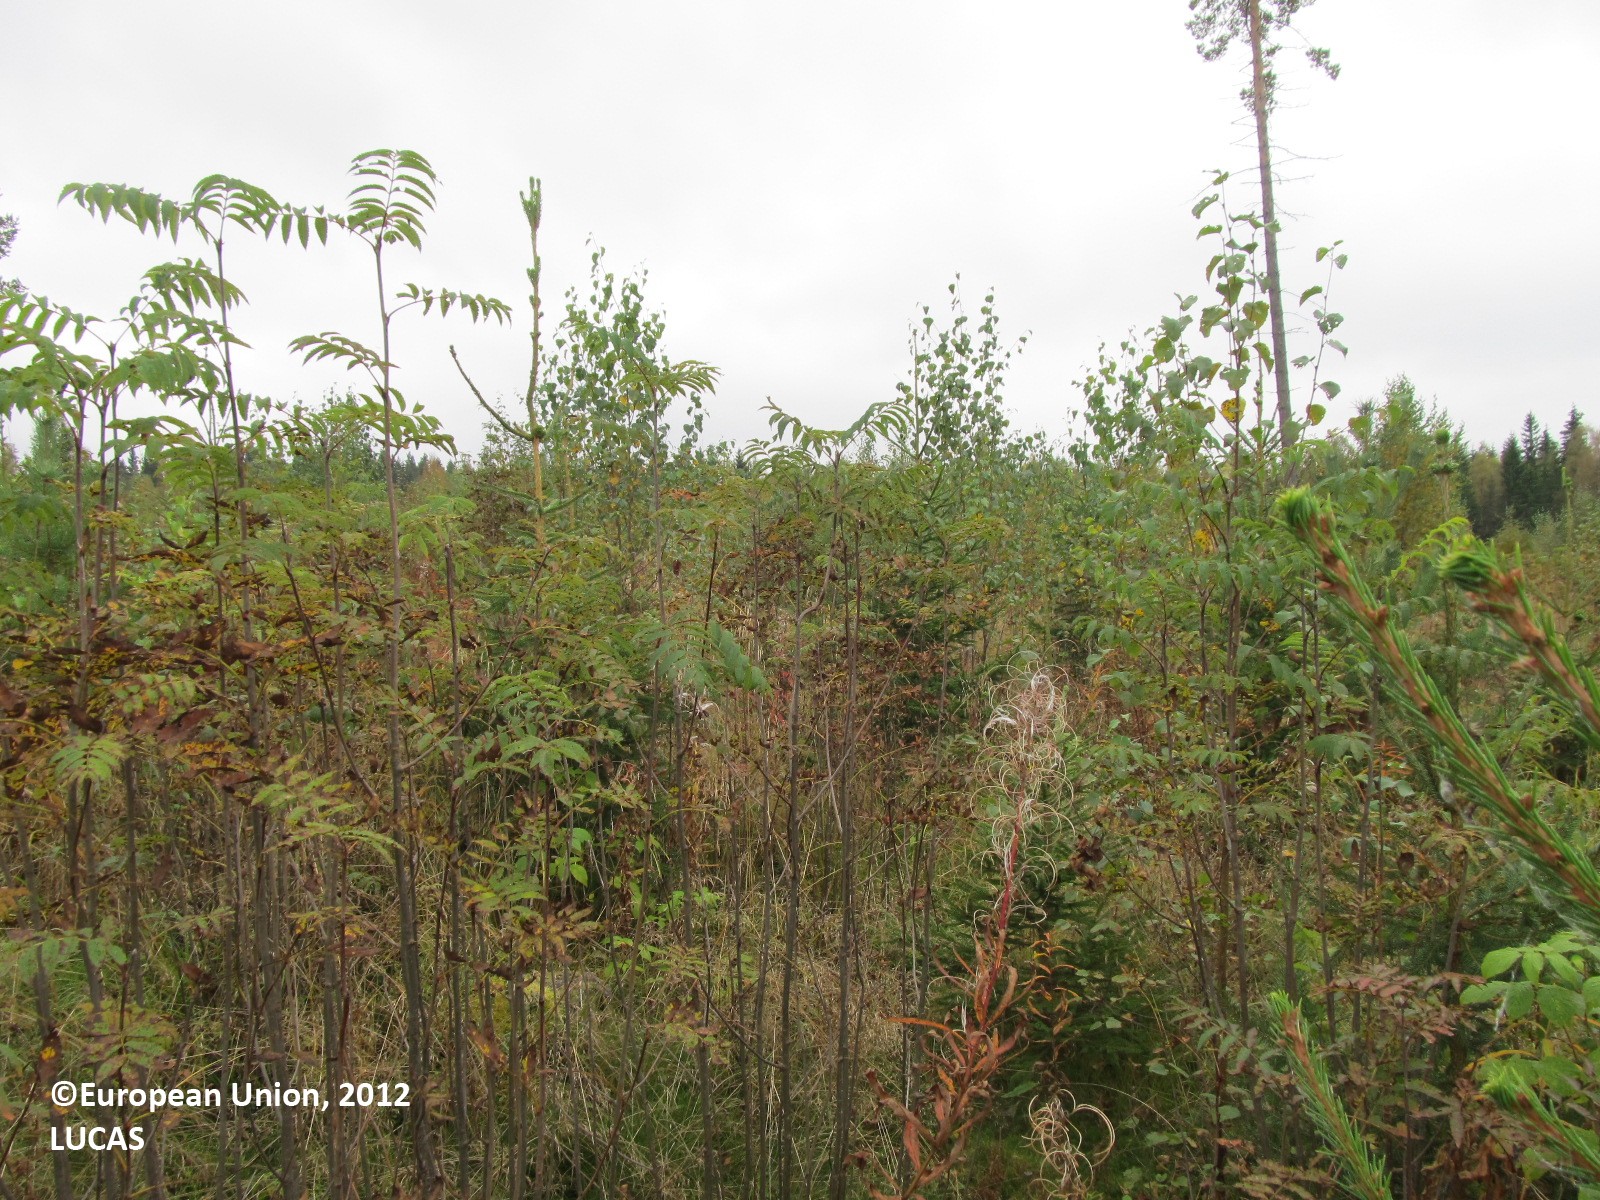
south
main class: Woodland
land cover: Spruce dominated mixed woodland
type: boreal forest
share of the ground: > 75 %
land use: Forestry
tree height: < 5 m
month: September
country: FI
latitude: 63.1222
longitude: 27.9186
